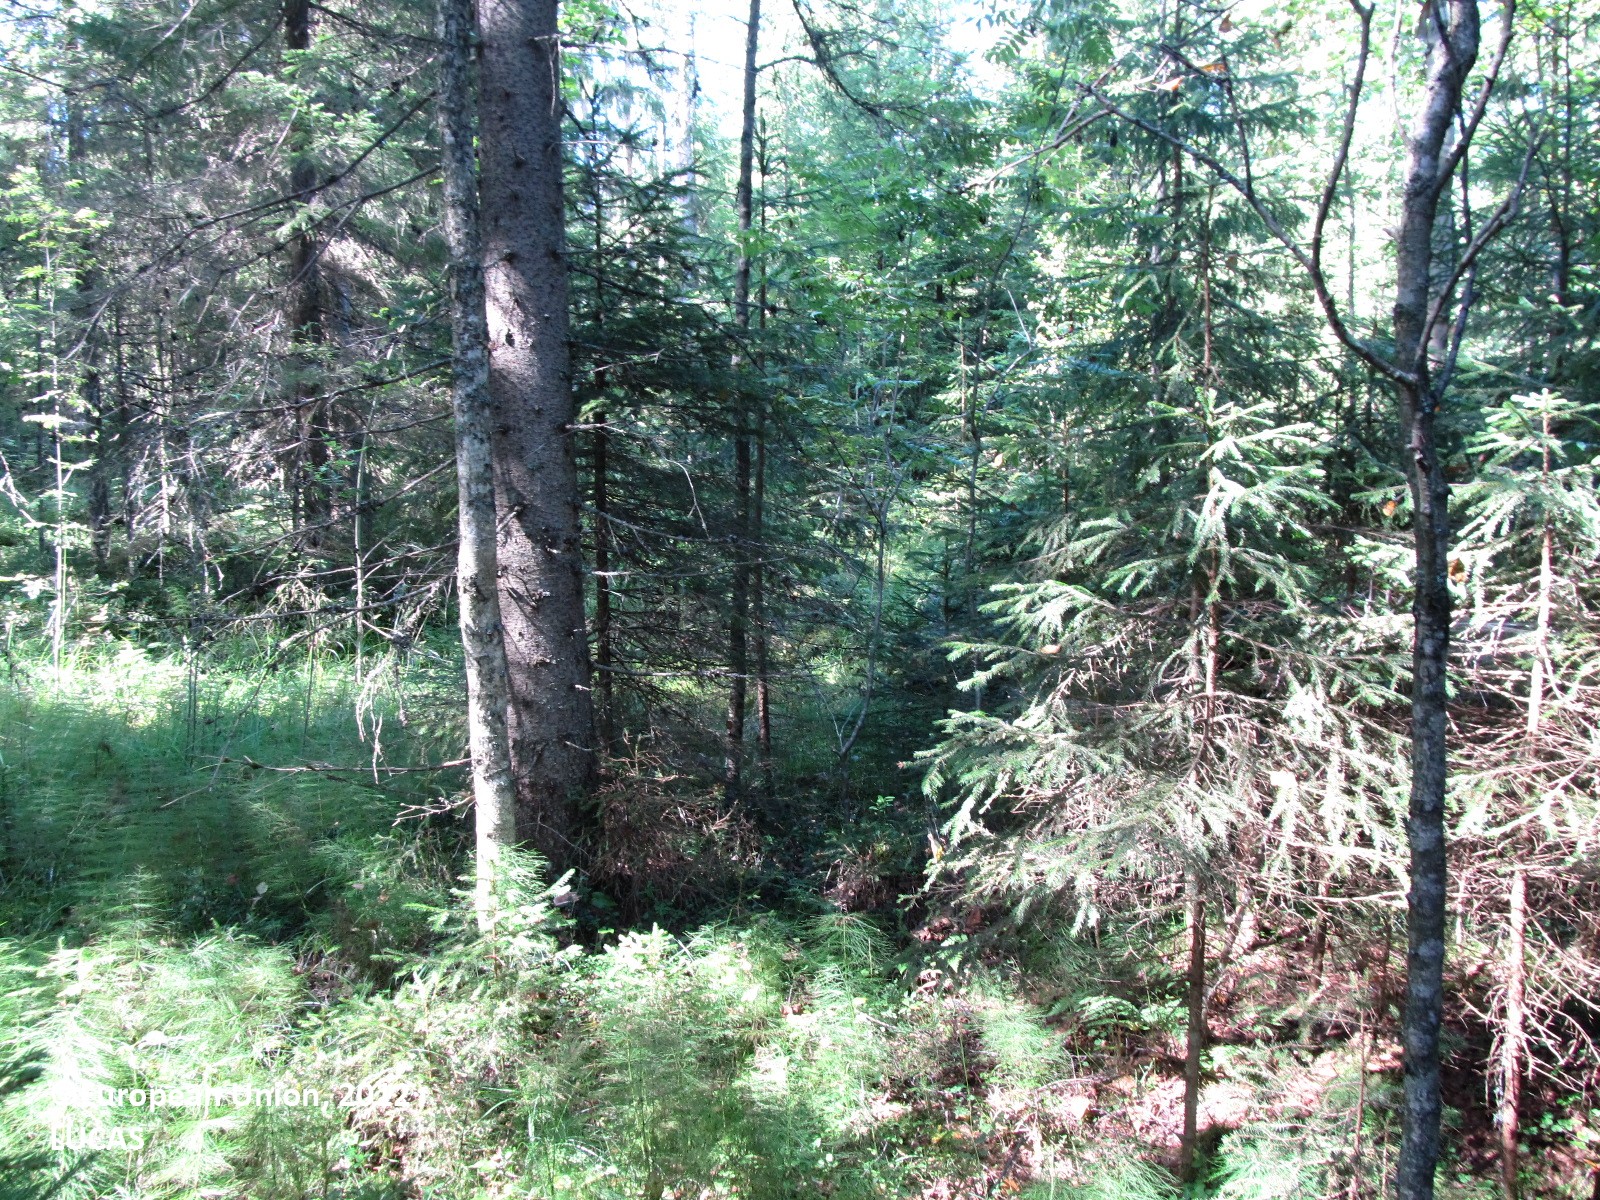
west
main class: Woodland
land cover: Spruce dominated coniferous woodland
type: boreal forest
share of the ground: 50 - 75 %
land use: Forestry
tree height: > 5 m
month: August
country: FI
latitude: 62.3010
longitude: 27.7852
